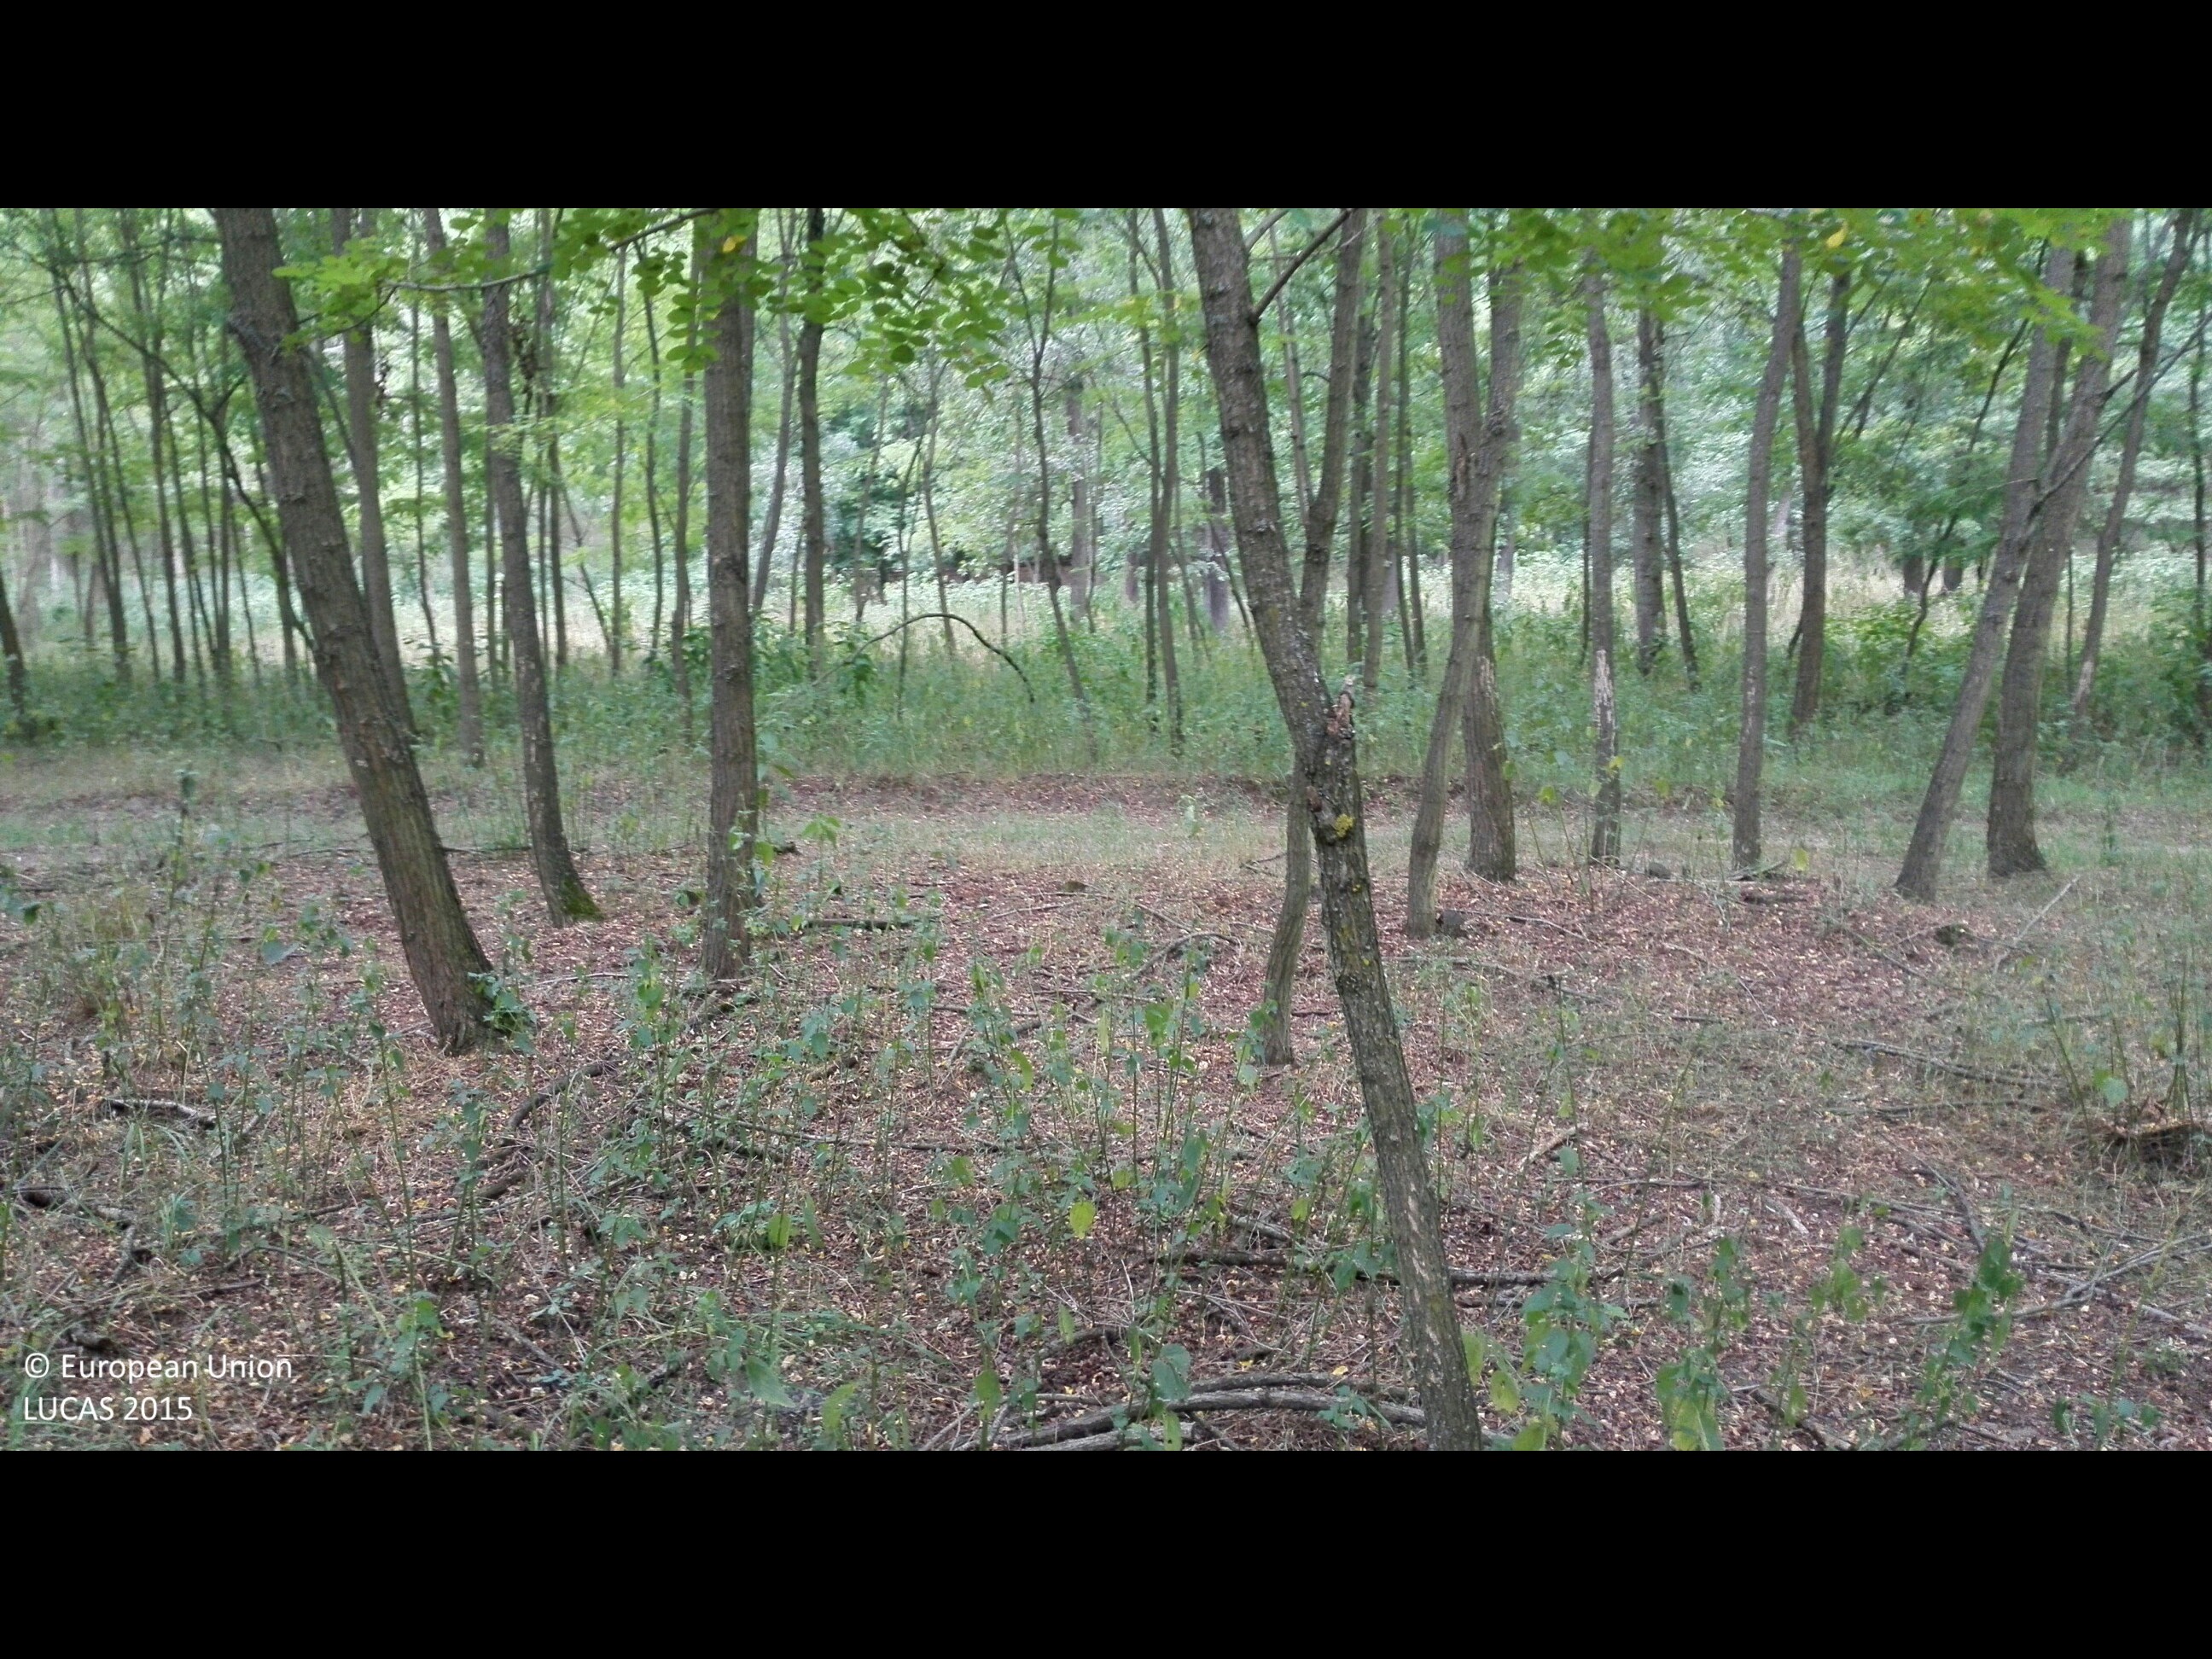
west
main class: Woodland
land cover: Broadleaved woodland
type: exotic forest
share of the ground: > 75 %
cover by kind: broadleaved forest trees 95 %, herbaceous plants 5 %
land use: Forestry
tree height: > 5 m
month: August
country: HU
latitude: 47.6392
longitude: 21.9895
